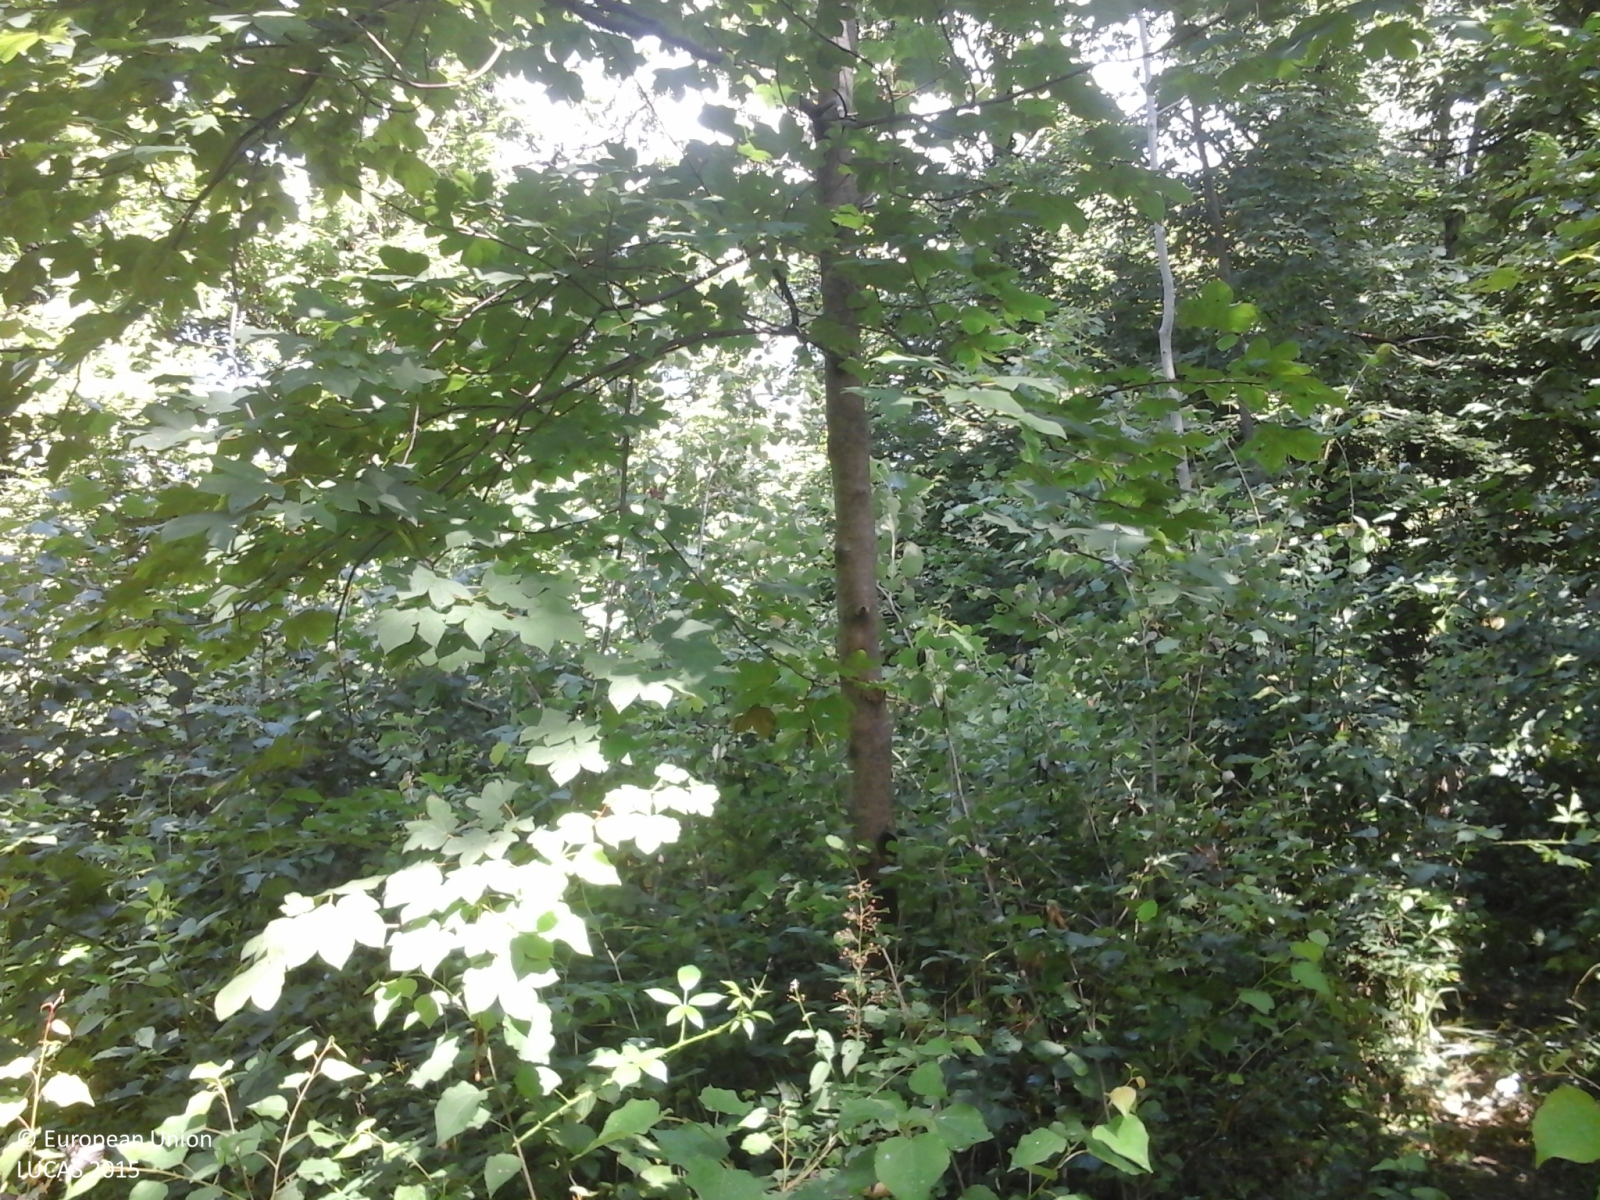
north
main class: Woodland
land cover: Broadleaved woodland
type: mesophytic deciduous forest
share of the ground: > 75 %
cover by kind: broadleaved forest trees 100 %
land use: Forestry
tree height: > 5 m
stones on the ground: 10 - 25 %
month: August
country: IT
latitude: 45.8990
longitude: 9.3694
